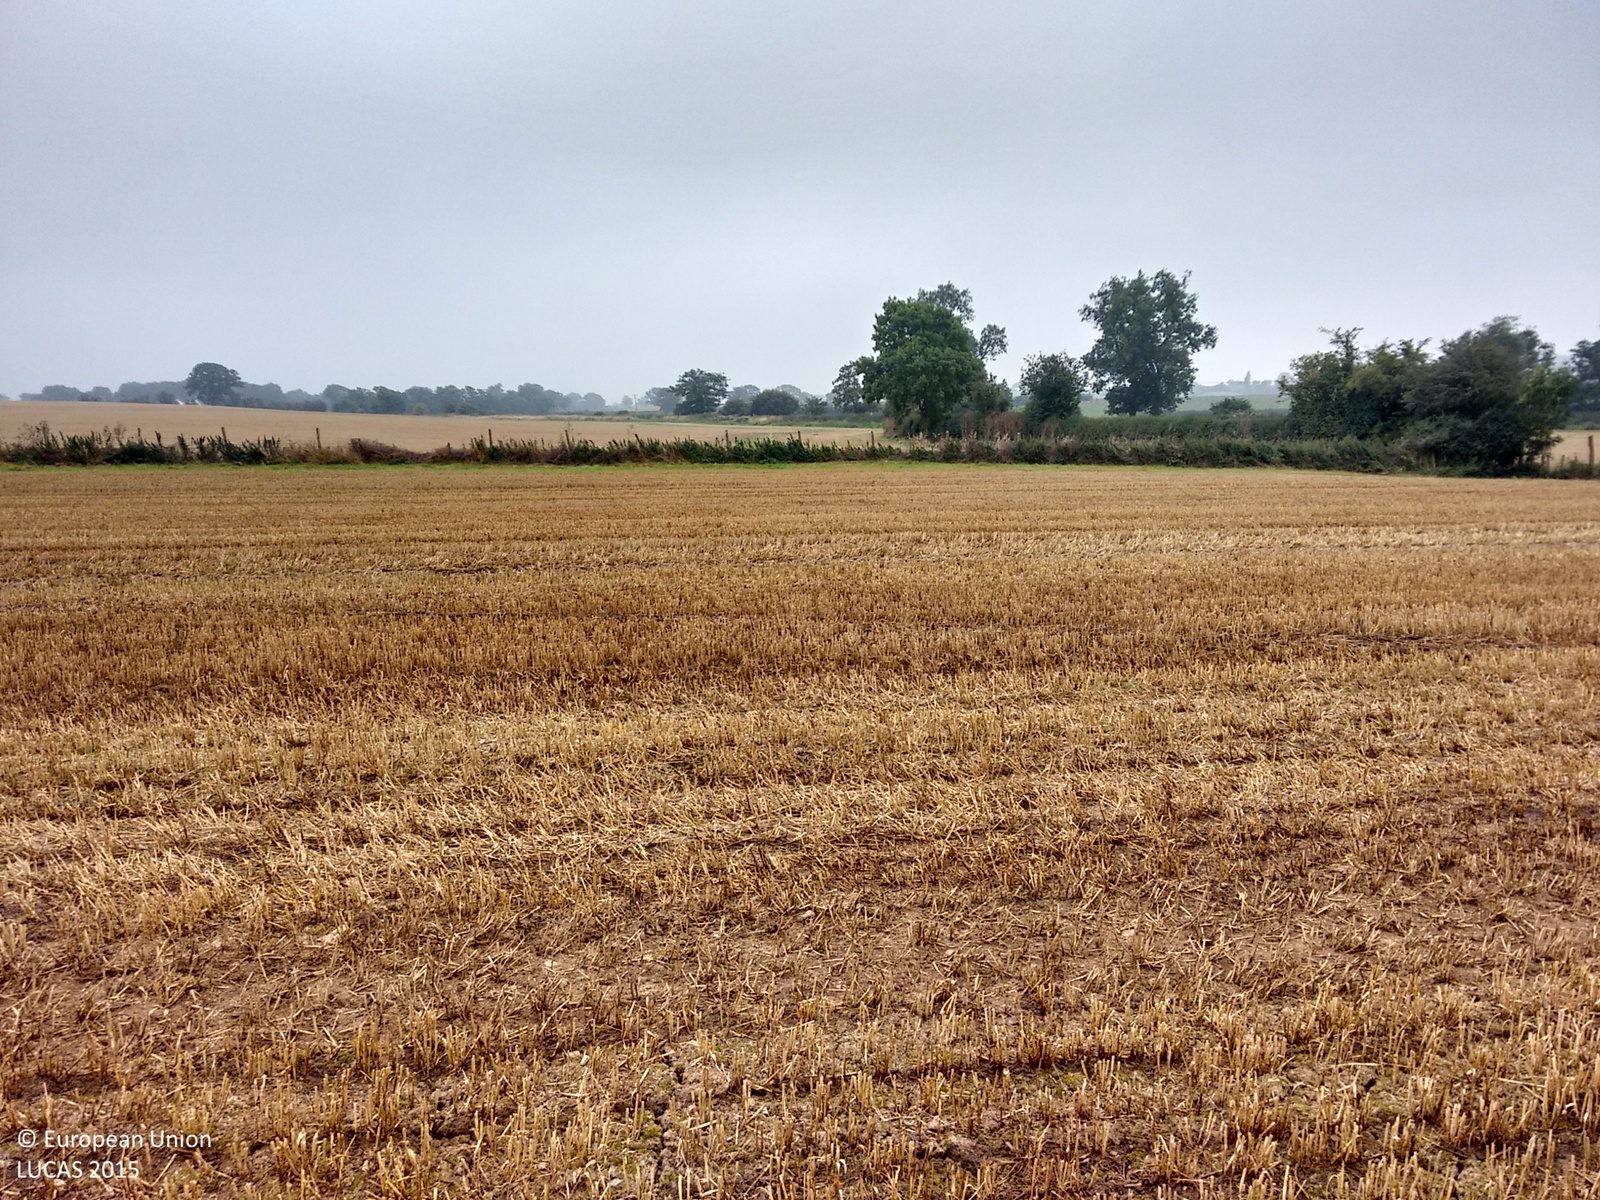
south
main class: Cropland
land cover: Common wheat
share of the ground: < 10 %
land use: Agriculture (excluding fallow land and kitchen gardens)
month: September
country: GB
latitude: 52.6868
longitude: -2.9293
